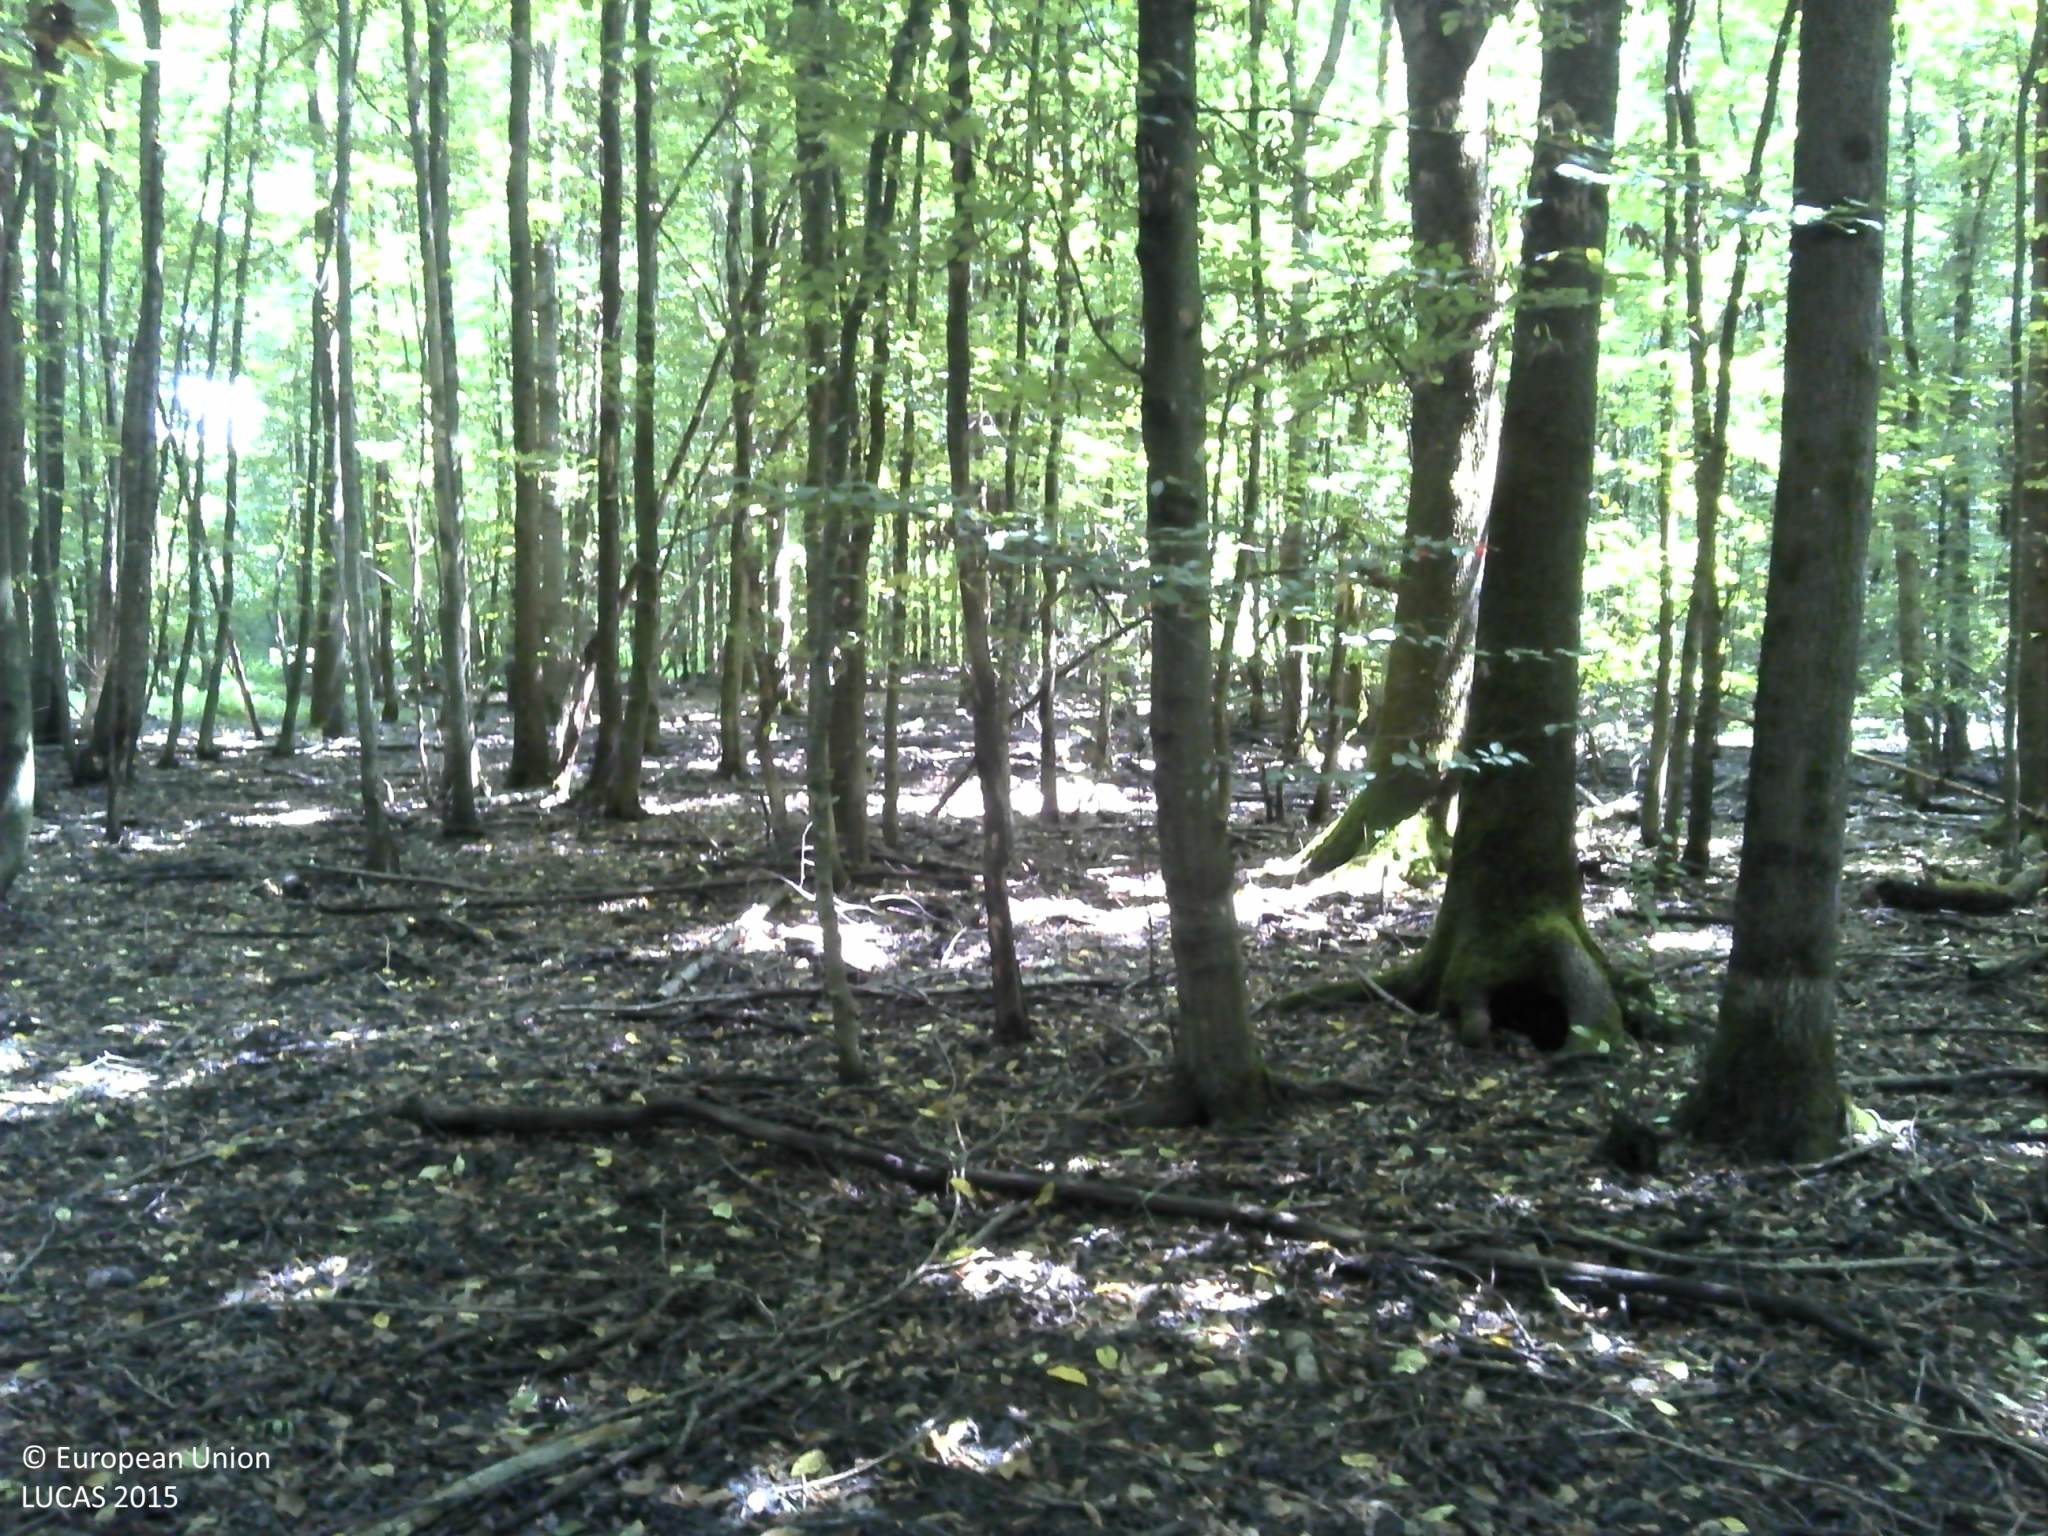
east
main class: Woodland
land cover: Broadleaved woodland
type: acidophilous oak and oak-birch forest
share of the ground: > 75 %
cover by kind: broadleaved forest trees 100 %
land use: Forestry
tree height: > 5 m
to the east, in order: Broadleaved woodland
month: August
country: HR
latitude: 45.5185
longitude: 16.5401
